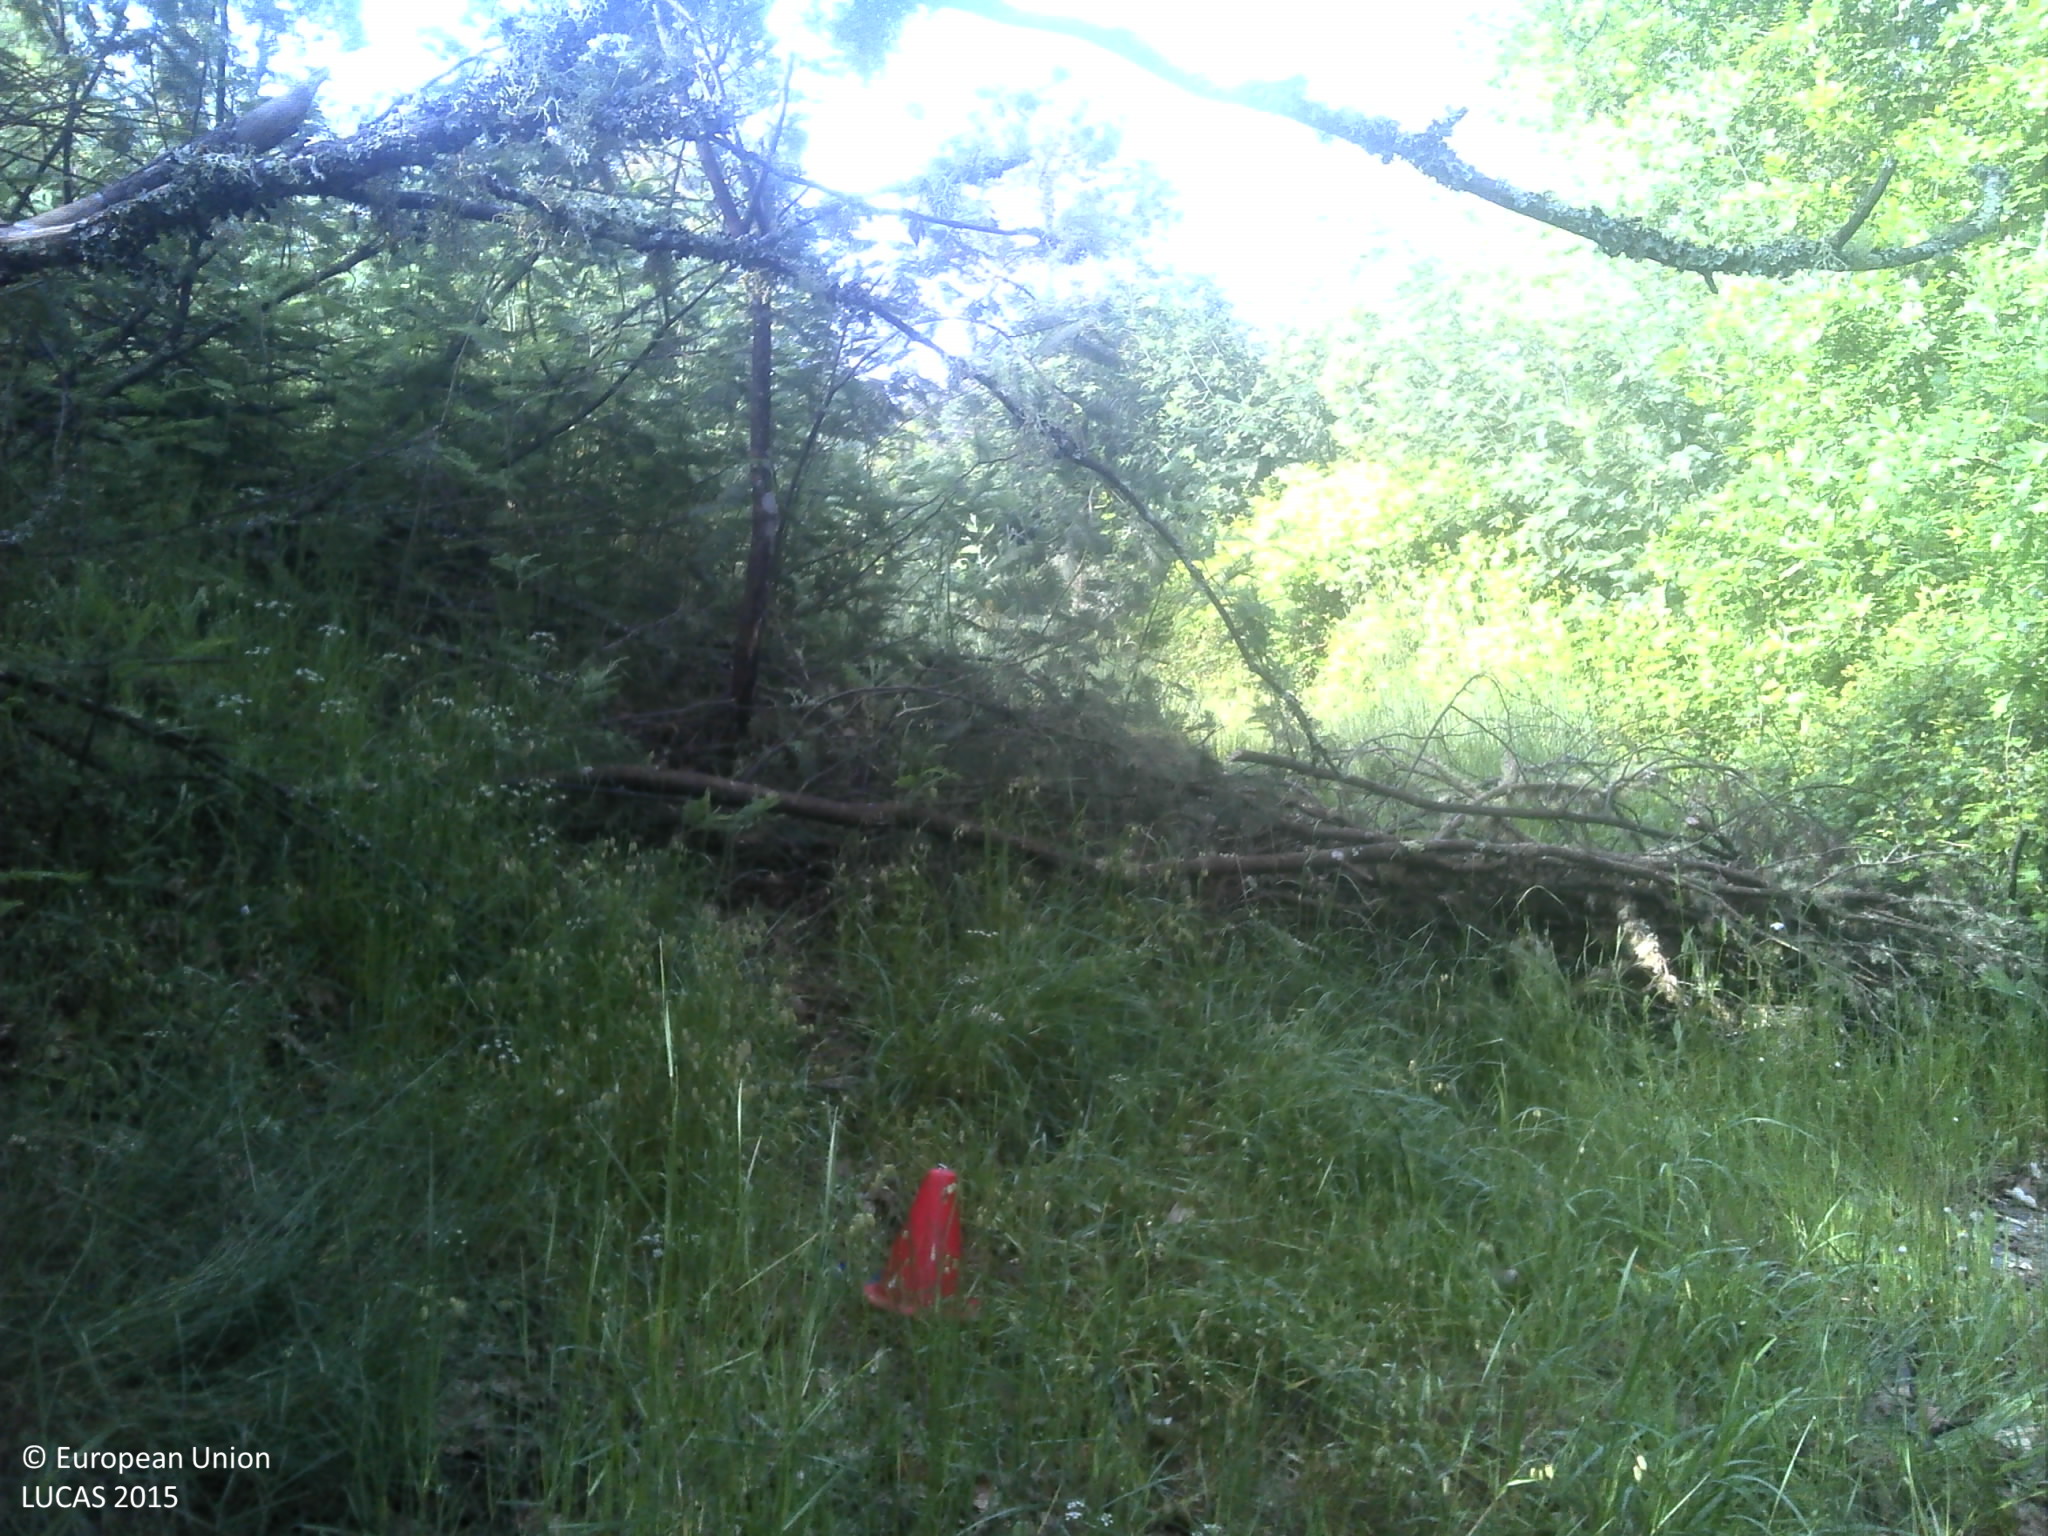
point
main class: Woodland
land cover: Broadleaved woodland
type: acidophilous oak and oak-birch forest
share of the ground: 25 - 50 %
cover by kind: broadleaved forest trees 50 %, shrubs 25 %, herbaceous plants 15 %, unconsolidated bare surface 10 %
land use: Forestry
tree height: > 5 m
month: May
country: PT
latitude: 40.6599
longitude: -7.7800
